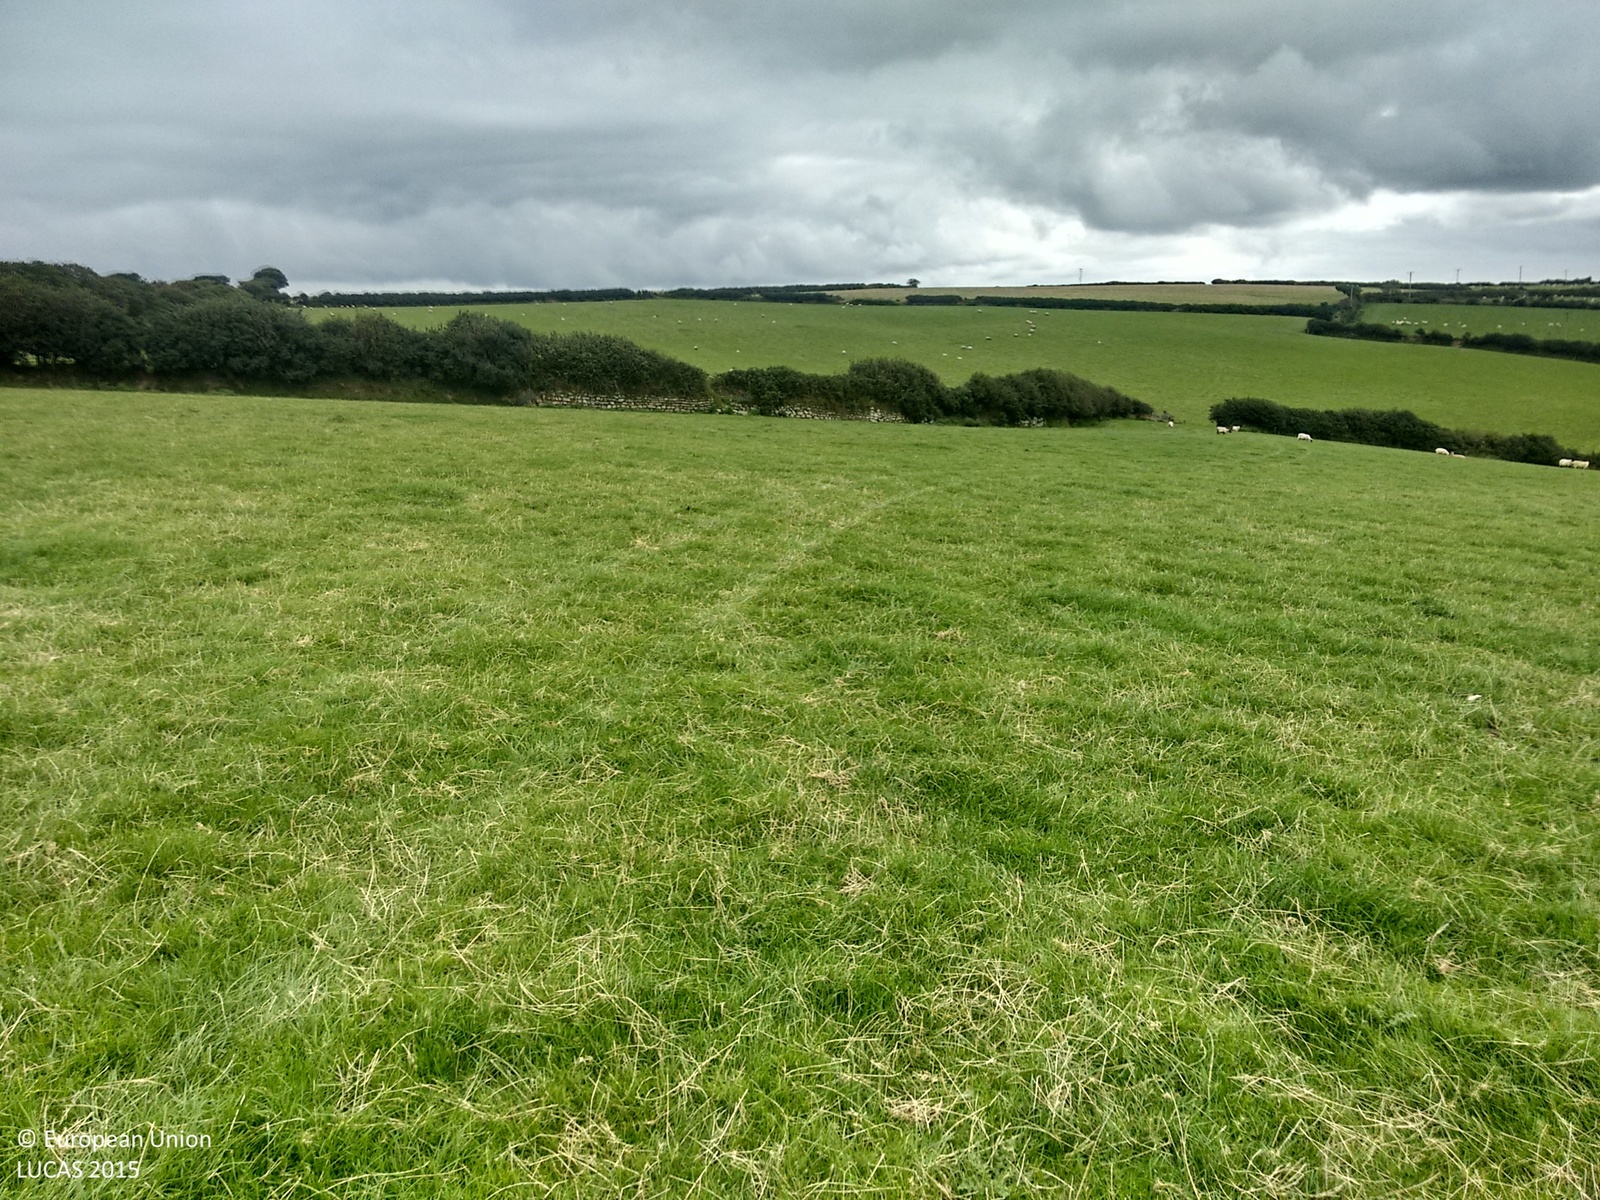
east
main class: Grassland
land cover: Grassland without tree/shrub cover
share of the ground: > 75 %
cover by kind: herbaceous plants 100 %
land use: Agriculture (excluding fallow land and kitchen gardens)
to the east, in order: Grassland without tree/shrub cover; Managed hedges; Artificial constructions; Grassland without tree/shrub cover
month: September
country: GB
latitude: 50.4292
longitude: -4.9953
